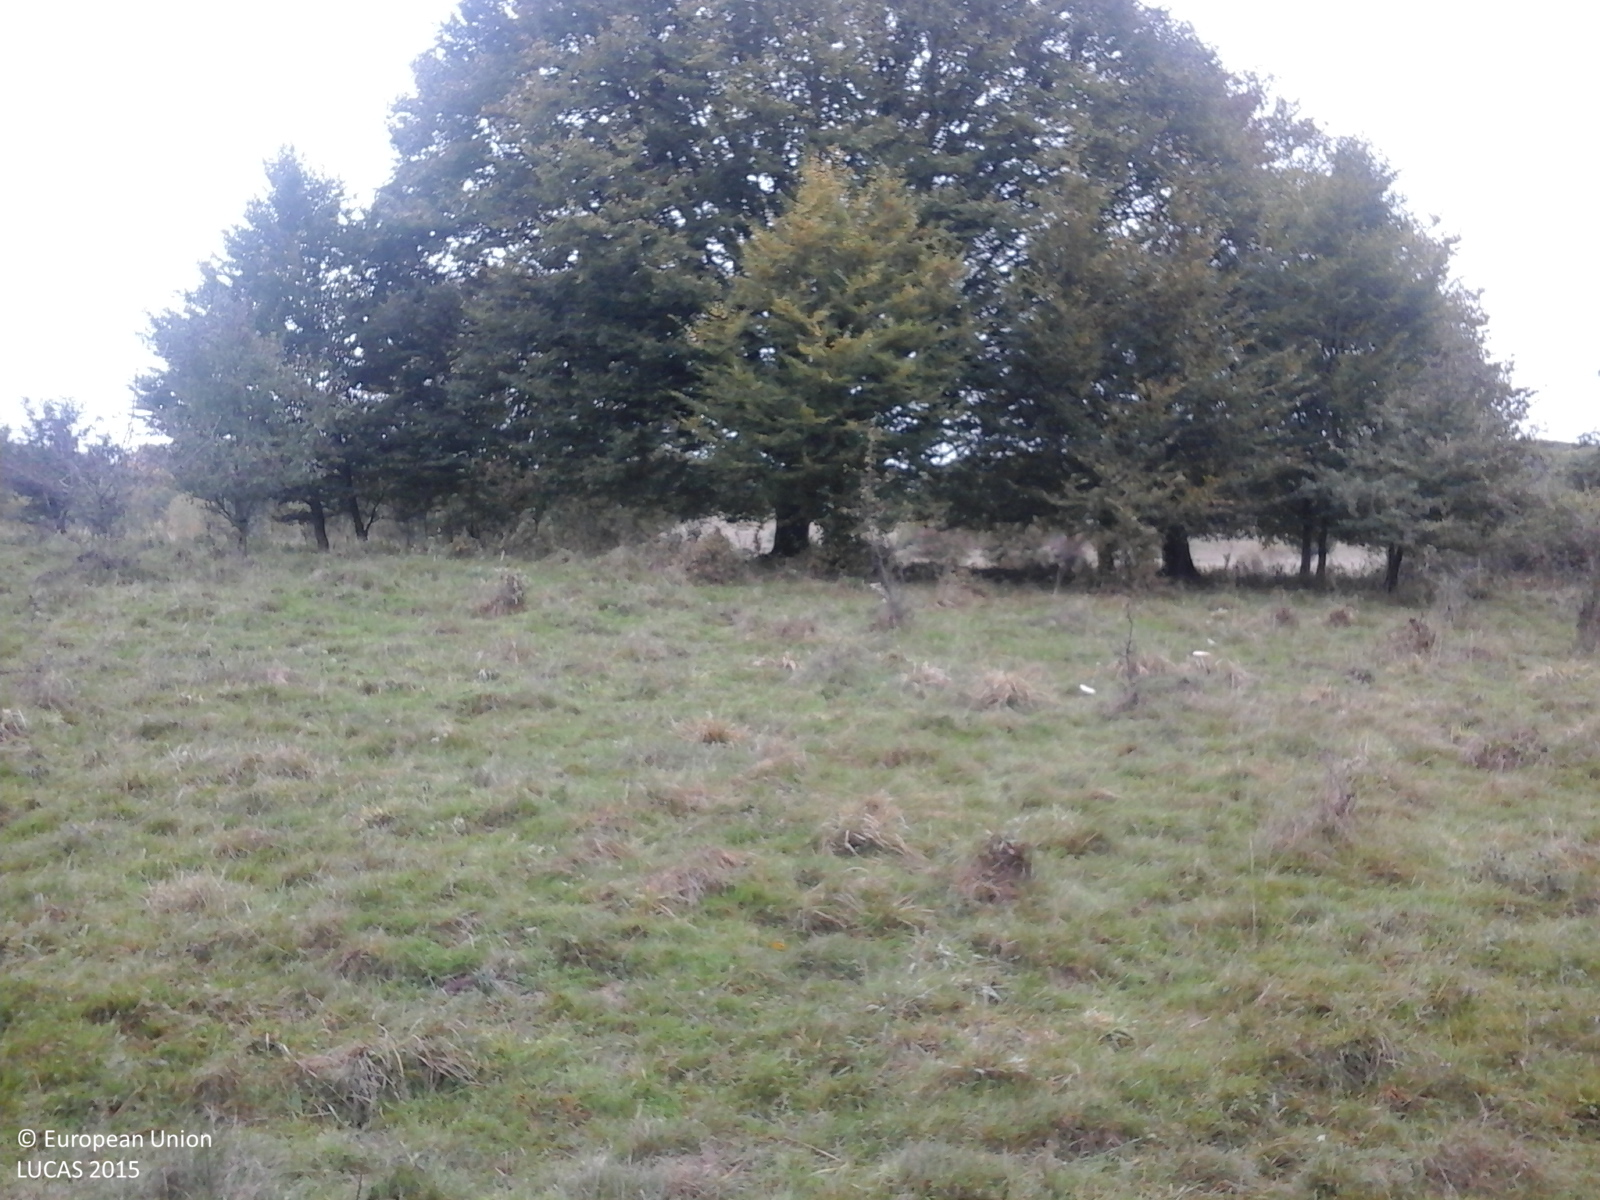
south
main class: Grassland
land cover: Grassland with sparse tree/shrub cover
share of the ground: > 75 %
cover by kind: herbaceous plants 85 %, shrubs 10 %, broadleaved forest trees 5 %
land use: Fallow land
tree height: < 5 m
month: October
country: RO
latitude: 45.9503
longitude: 24.7037
